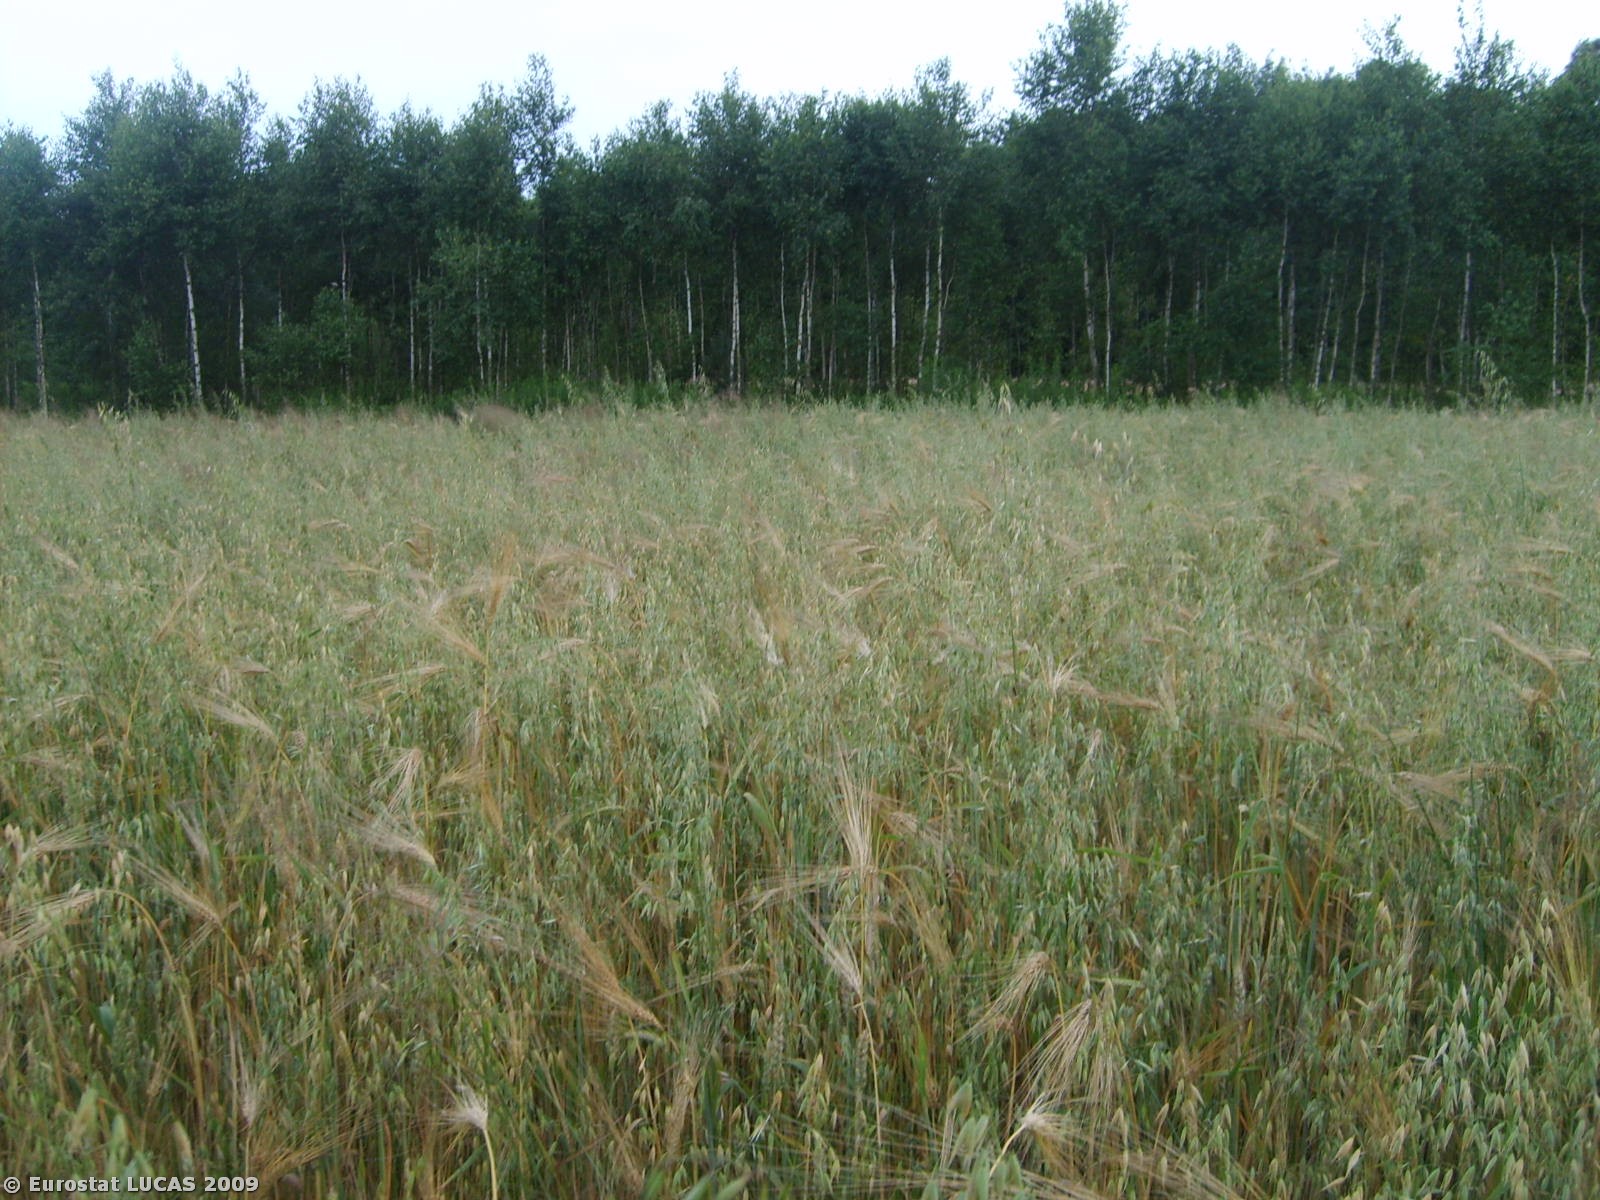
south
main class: Cropland
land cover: Mixed cereals for fodder
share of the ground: > 75 %
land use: Agriculture (excluding fallow land and kitchen gardens)
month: July
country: PL
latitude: 50.1473
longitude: 21.1145
